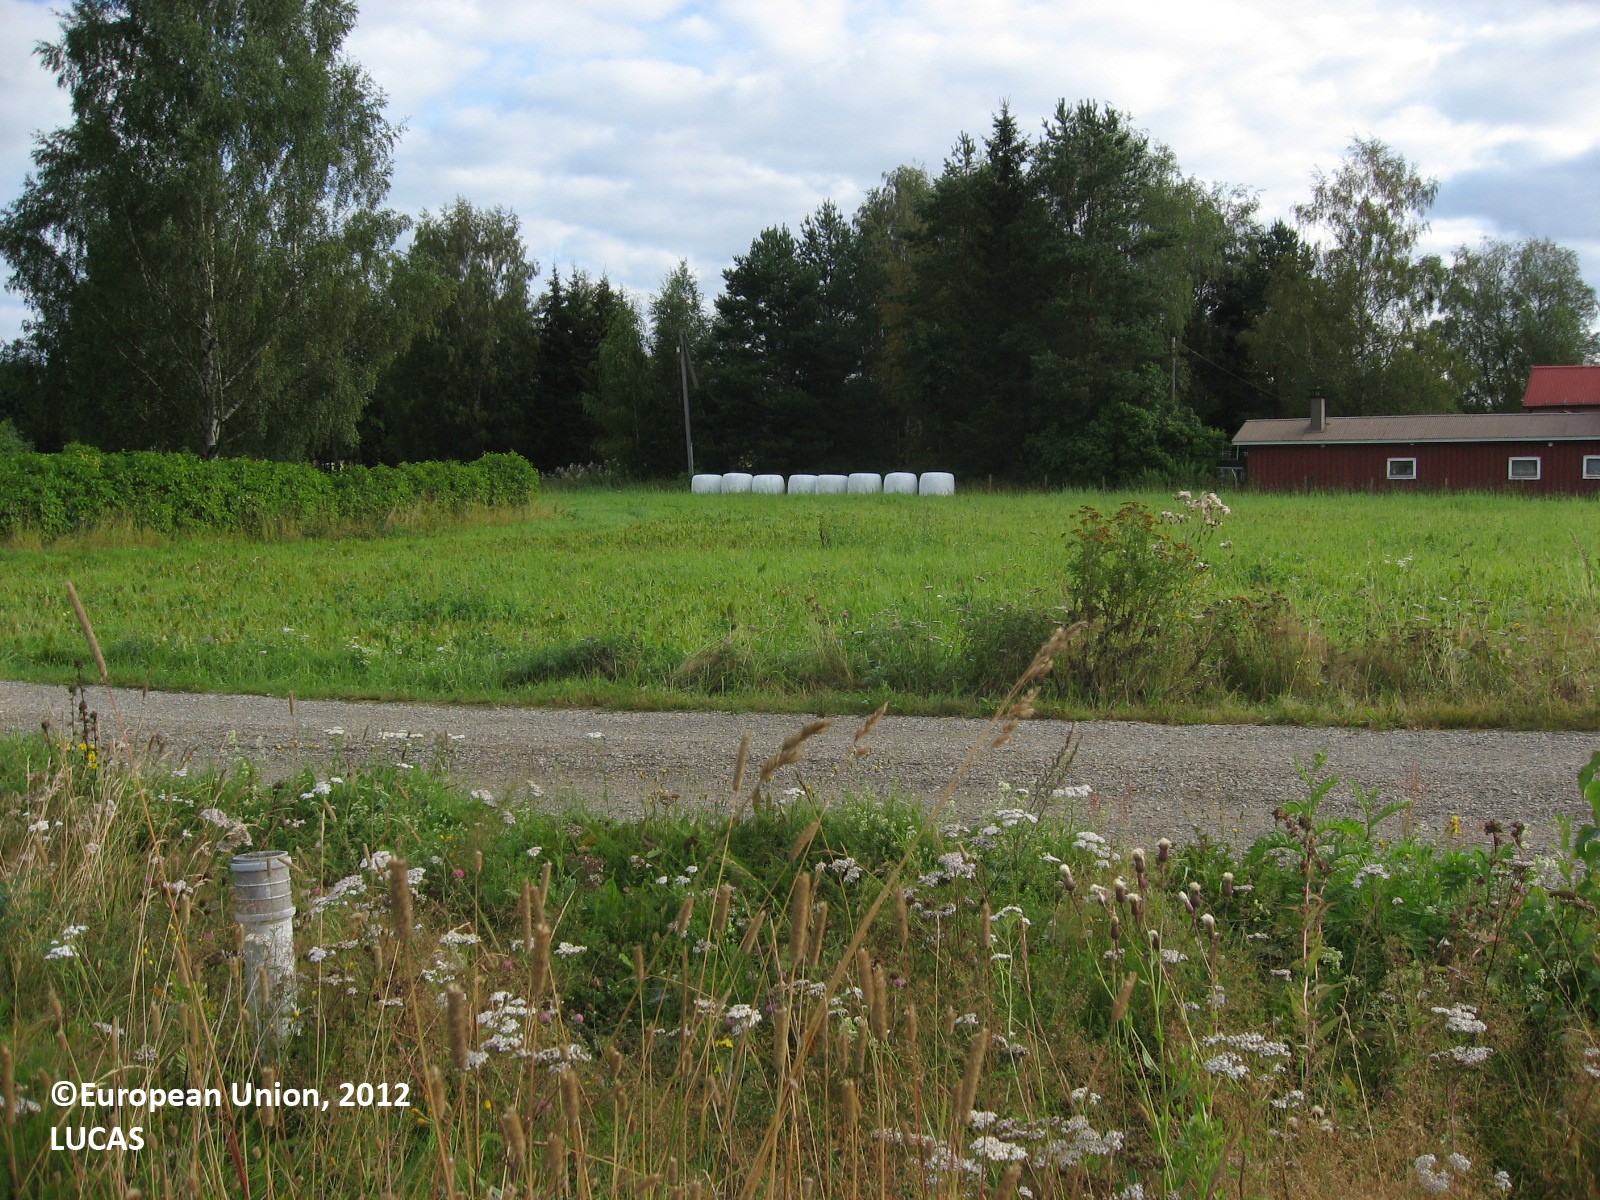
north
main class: Cropland
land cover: Temporary grasslands
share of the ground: > 75 %
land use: Agriculture (excluding fallow land and kitchen gardens)
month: August
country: FI
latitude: 61.1606
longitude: 24.7705
